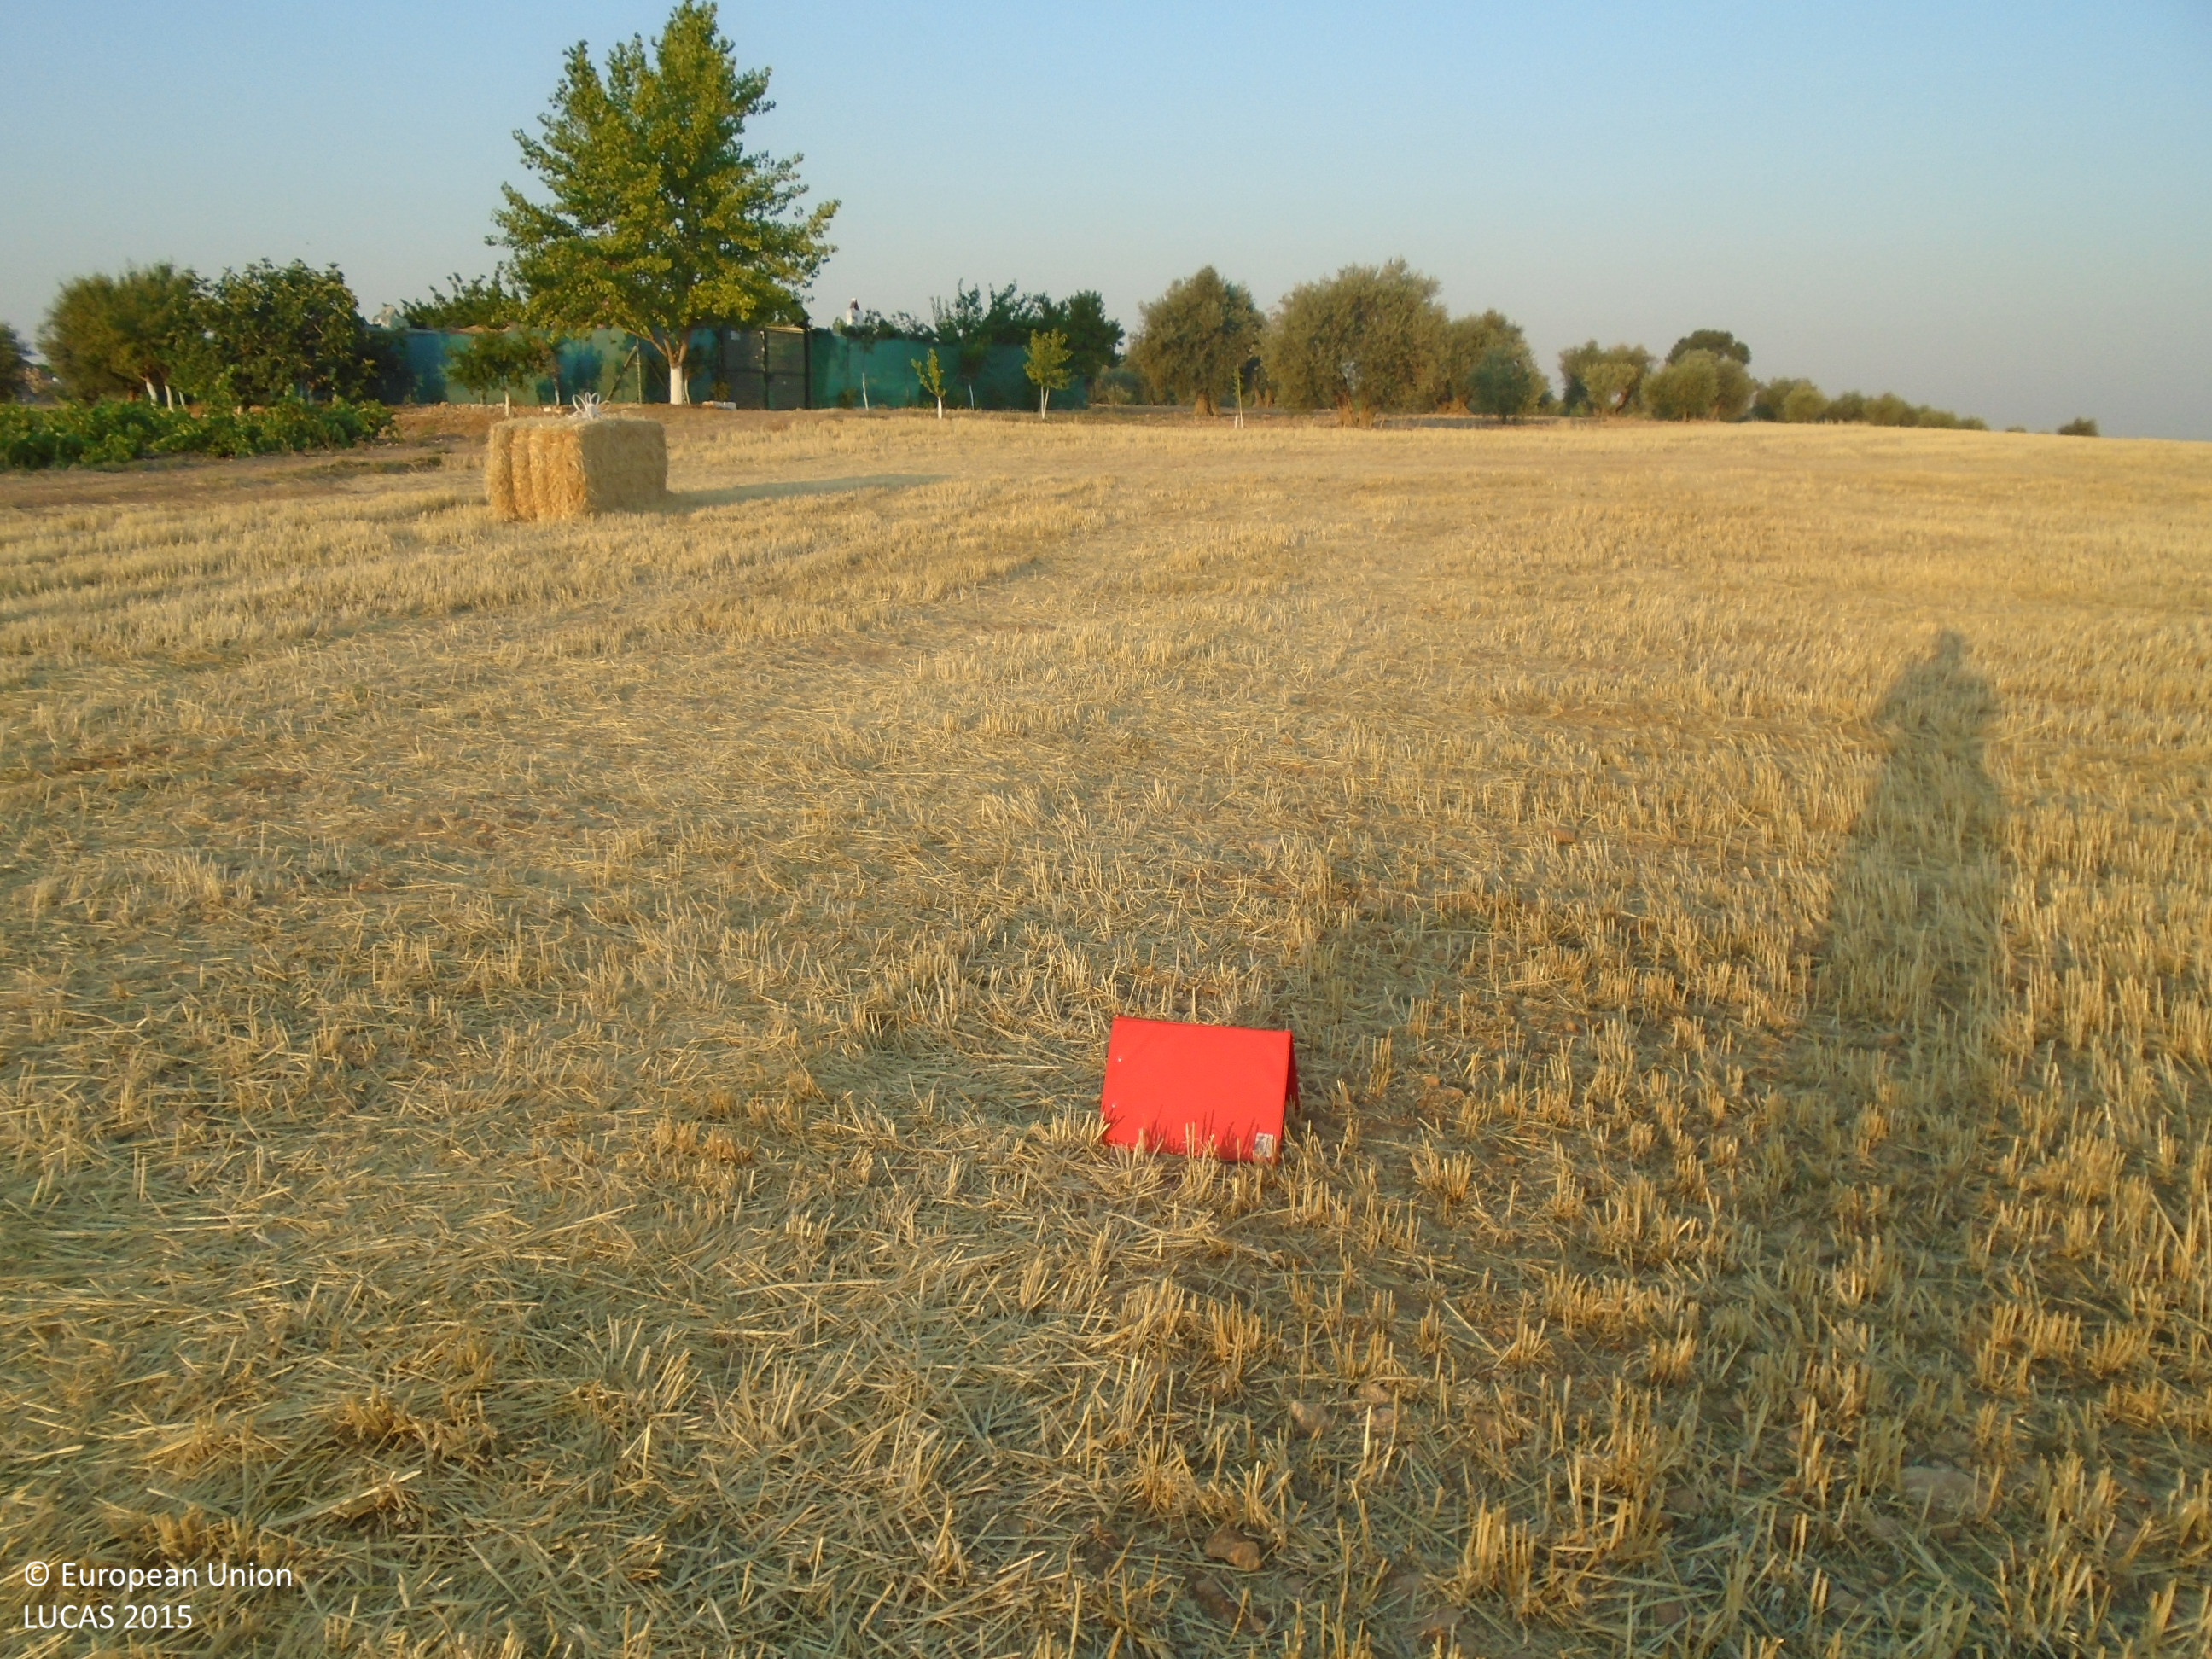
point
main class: Cropland
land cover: Barley
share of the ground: > 75 %
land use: Agriculture (excluding fallow land and kitchen gardens)
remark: Harvested field
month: June
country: ES
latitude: 39.1096
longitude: -3.6302
